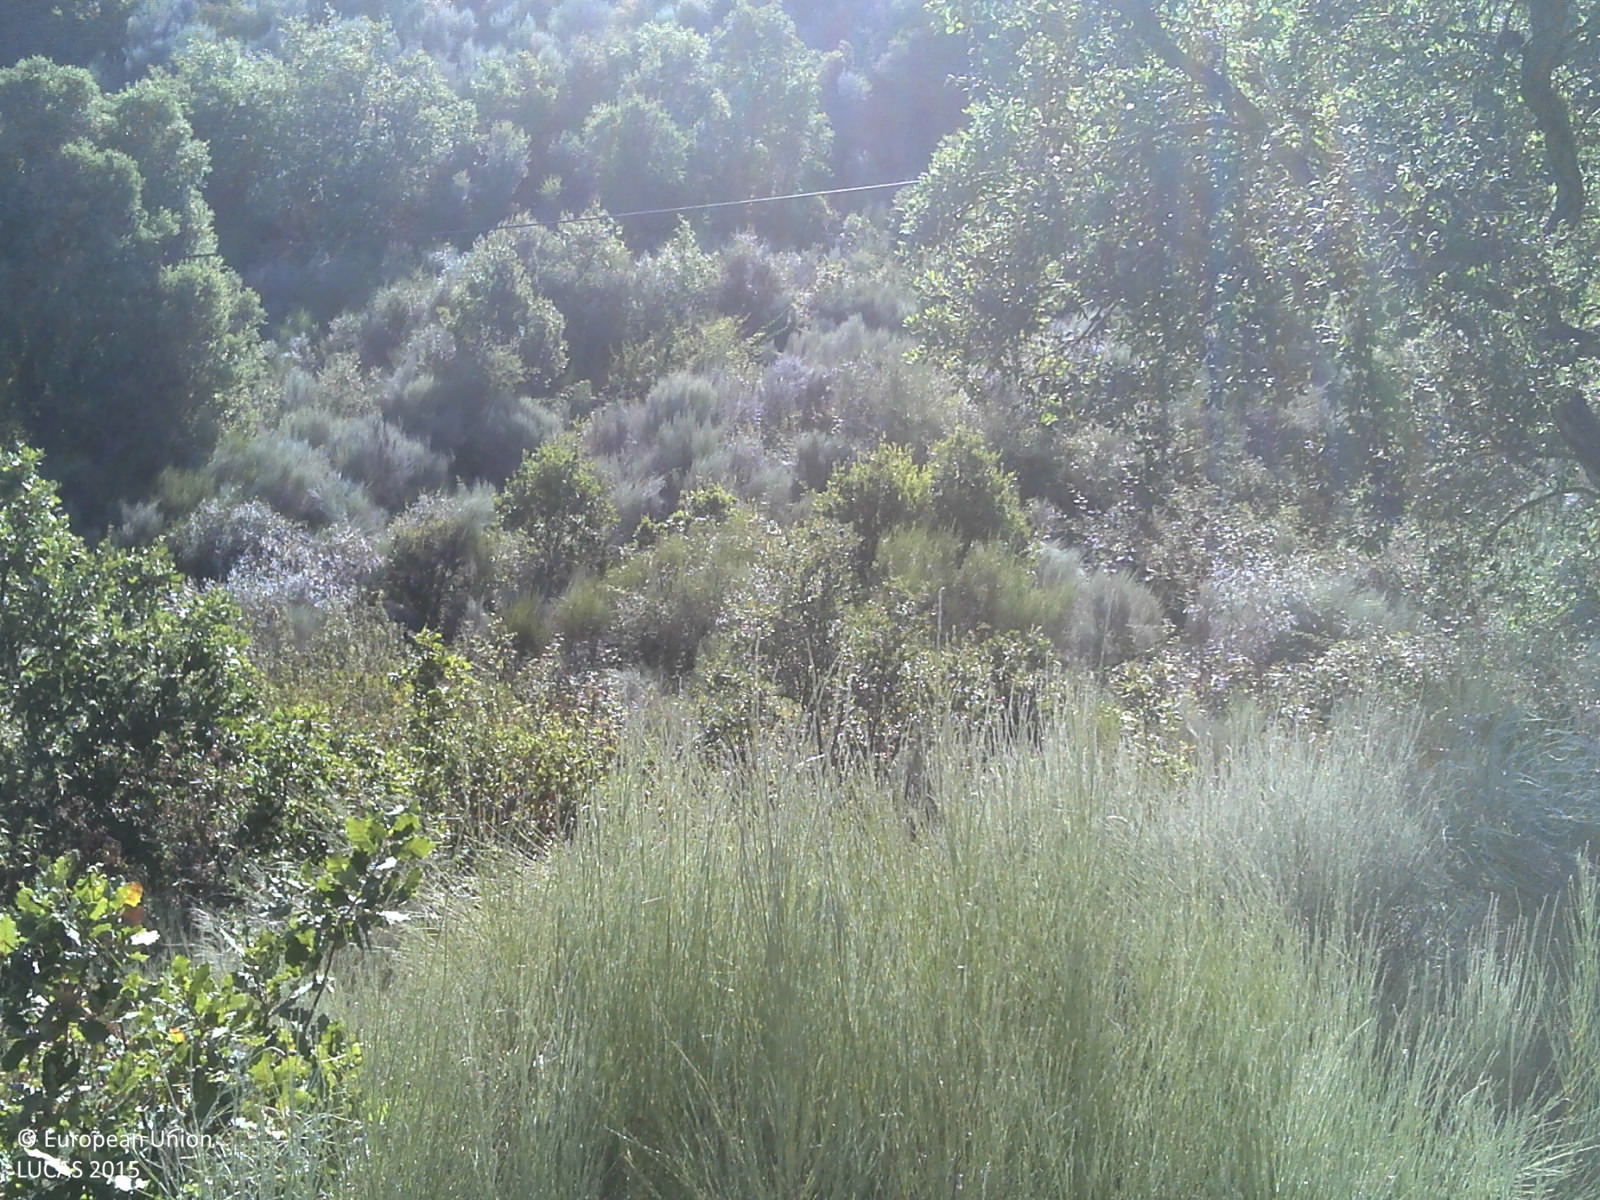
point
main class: Shrubland
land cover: Shrubland with sparse tree cover
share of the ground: > 75 %
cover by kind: shrubs 95 %, broadleaved forest trees 5 %
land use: Semi-natural and natural areas not in use
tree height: > 5 m
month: July
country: PT
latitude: 41.4098
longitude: -7.0907
